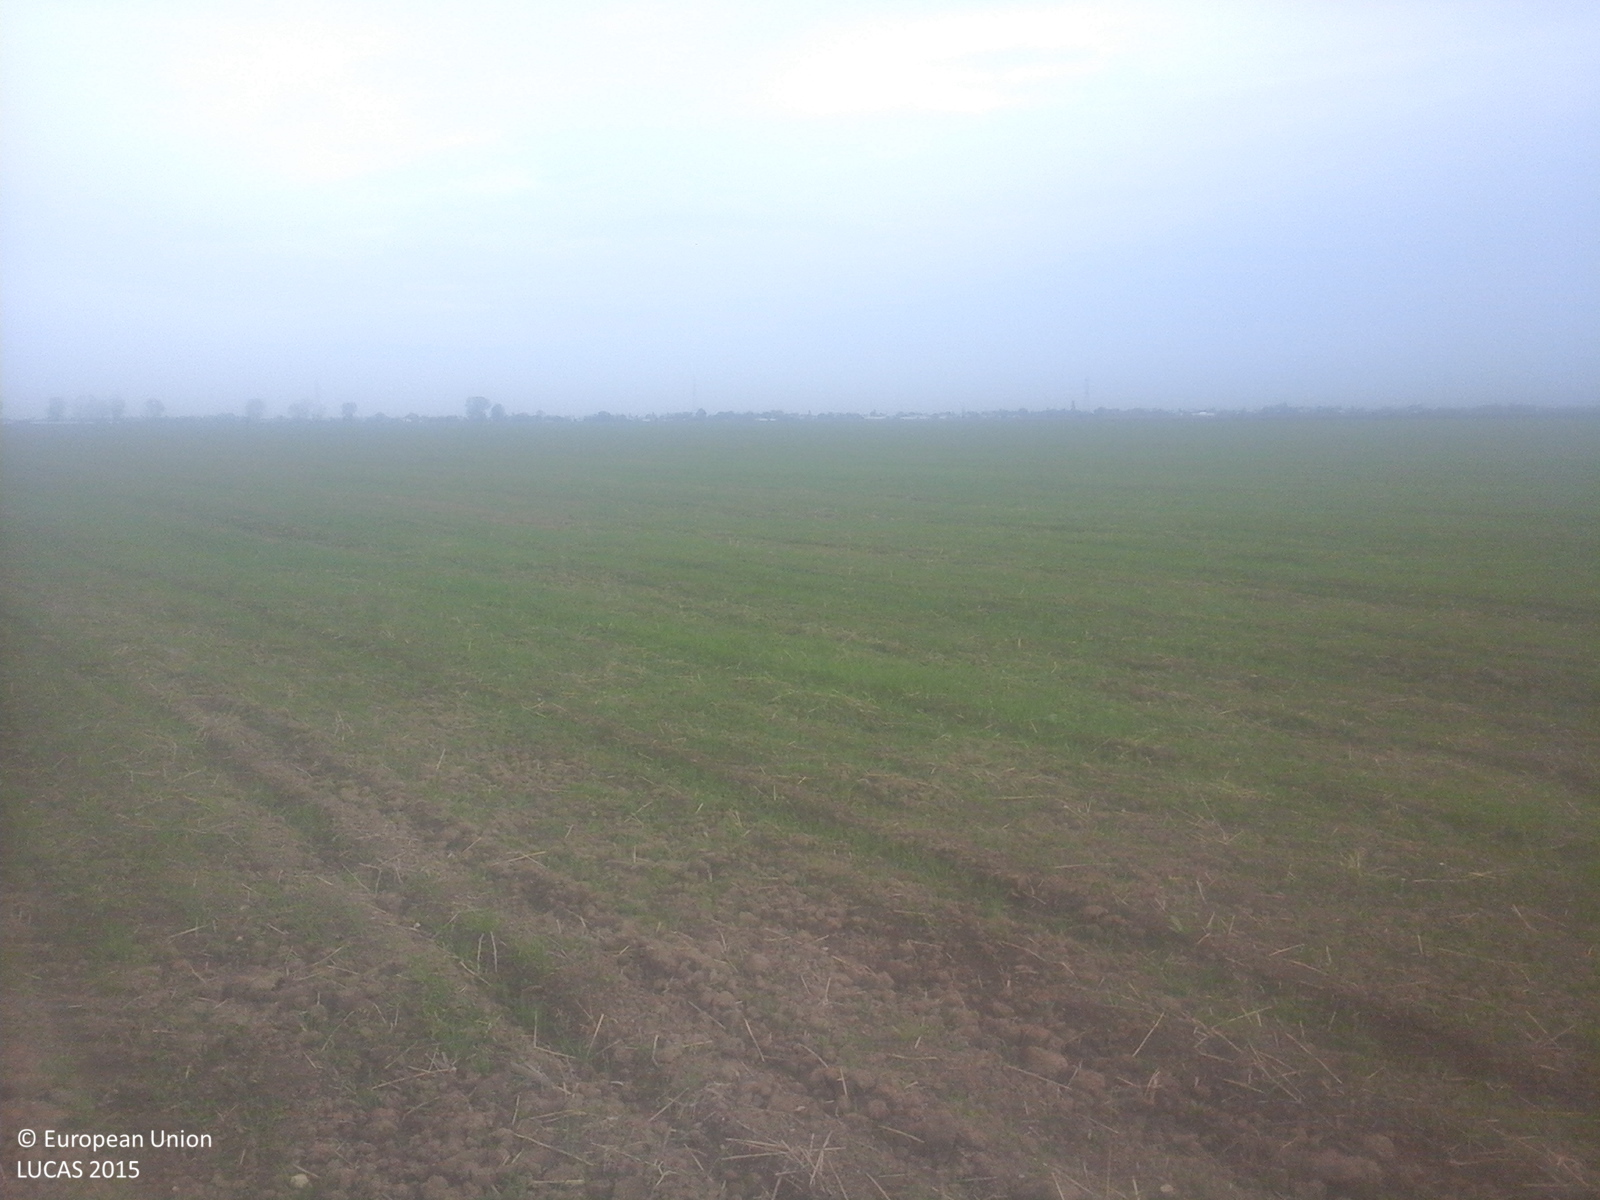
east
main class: Cropland
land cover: Common wheat
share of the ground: 10 - 25 %
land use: Agriculture (excluding fallow land and kitchen gardens)
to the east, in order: Common wheat
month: October
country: RO
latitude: 44.9502
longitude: 25.7814
